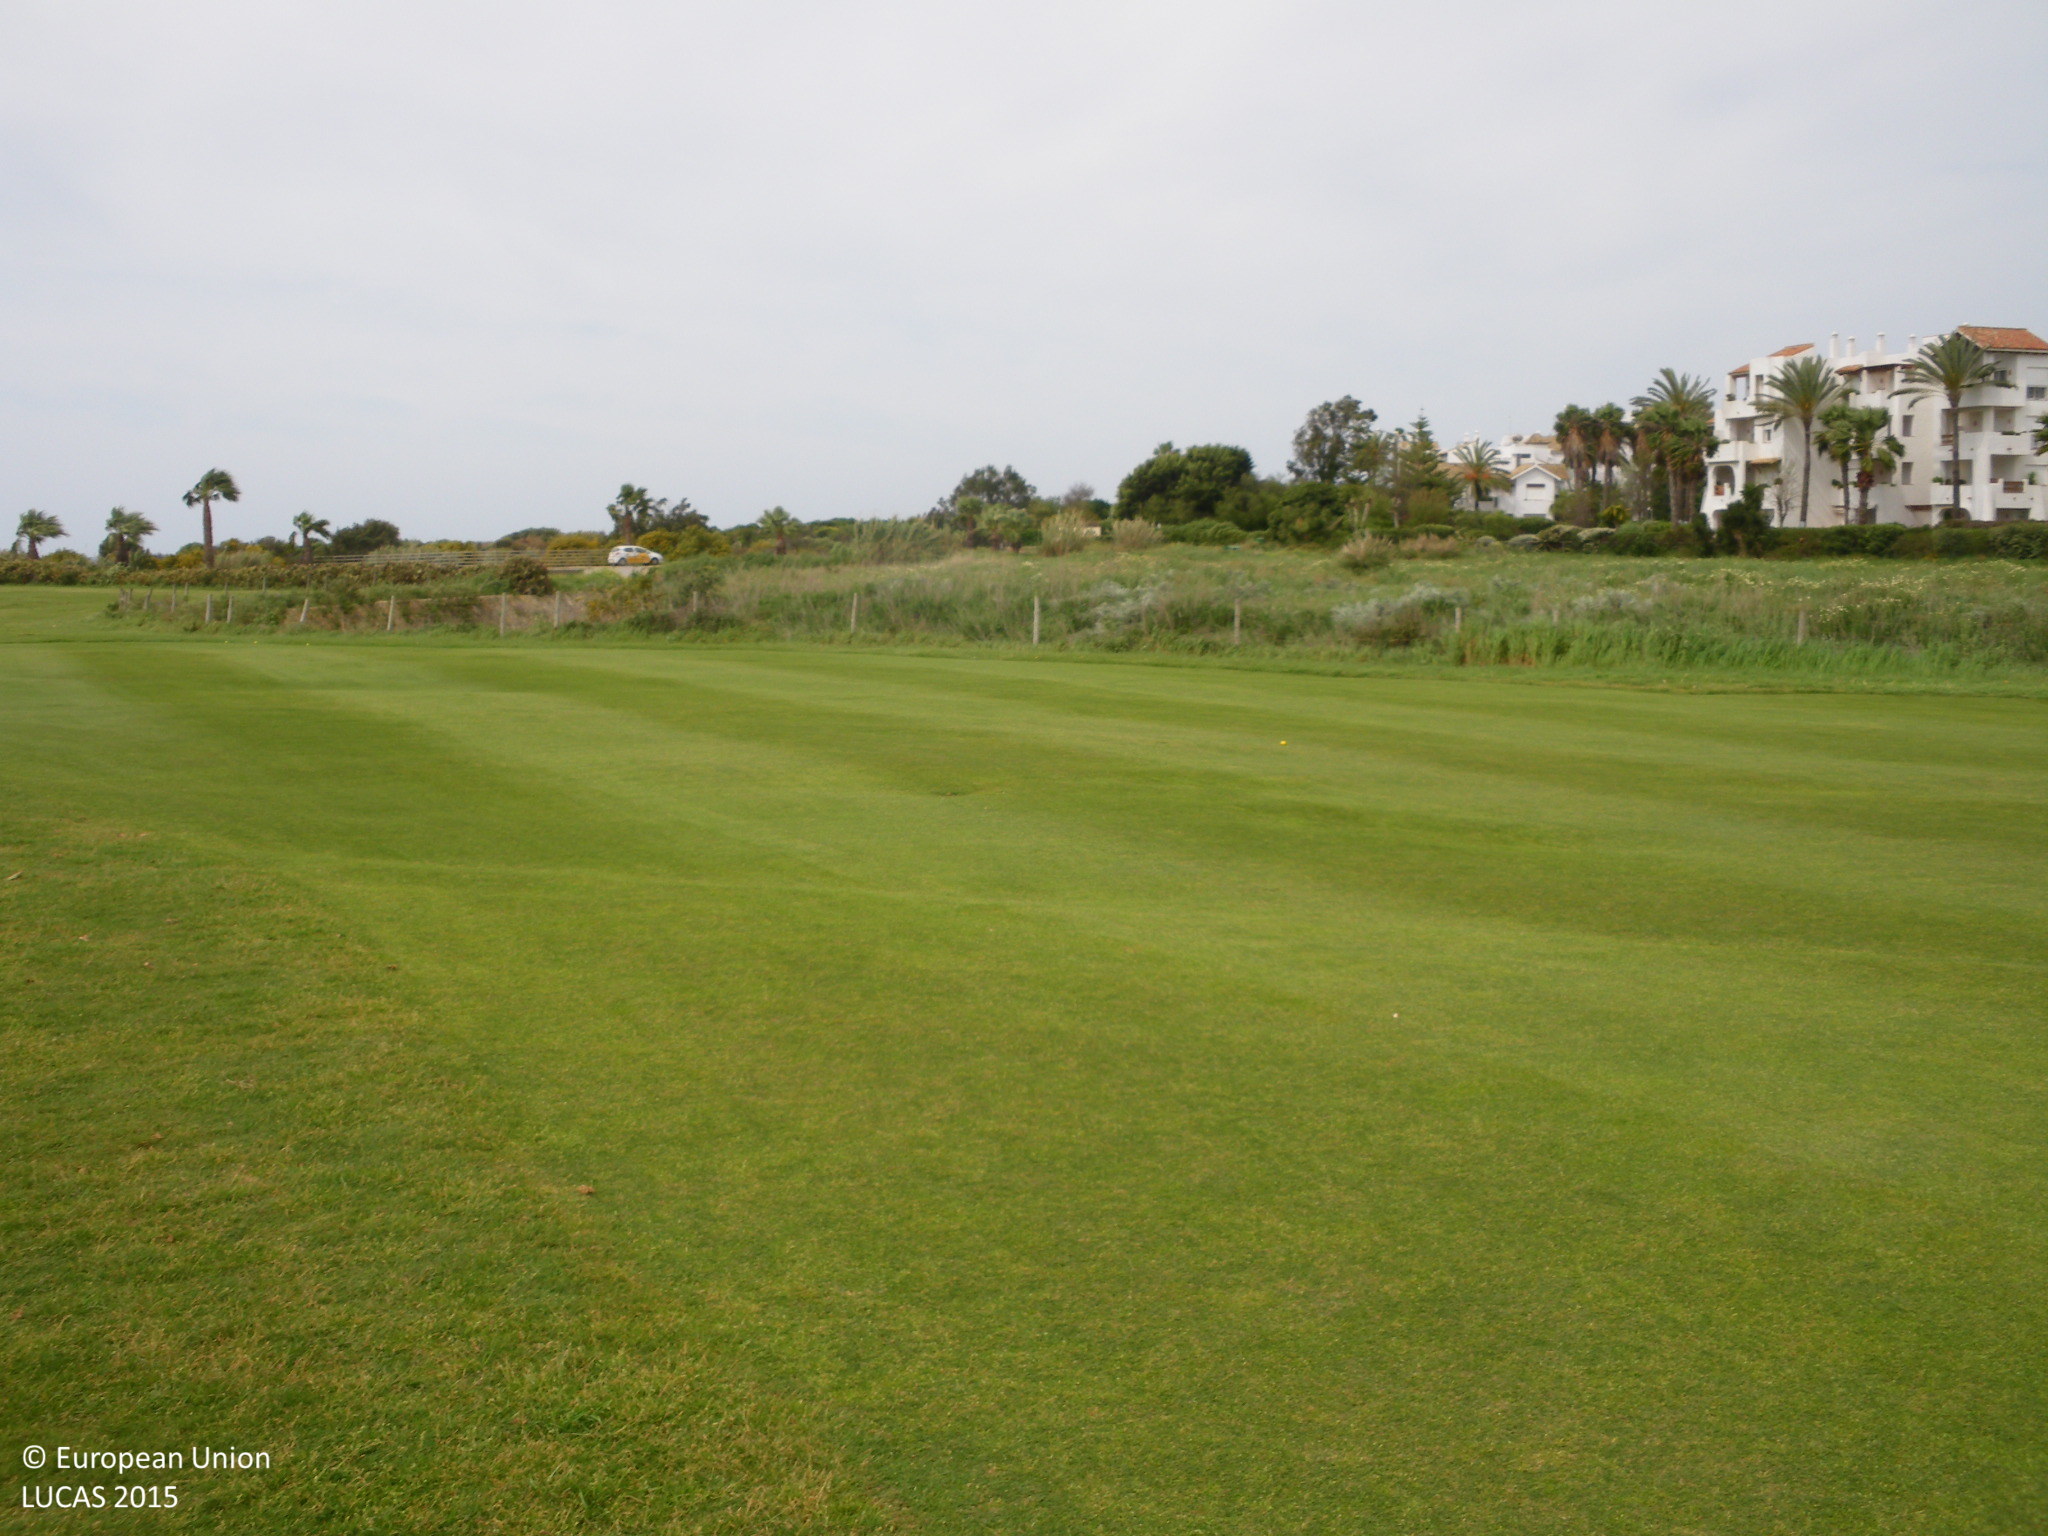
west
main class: Grassland
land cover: Grassland without tree/shrub cover
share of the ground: > 75 %
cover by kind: herbaceous plants 100 %
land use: Sport
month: April
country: ES
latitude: 36.6805
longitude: -6.4105
